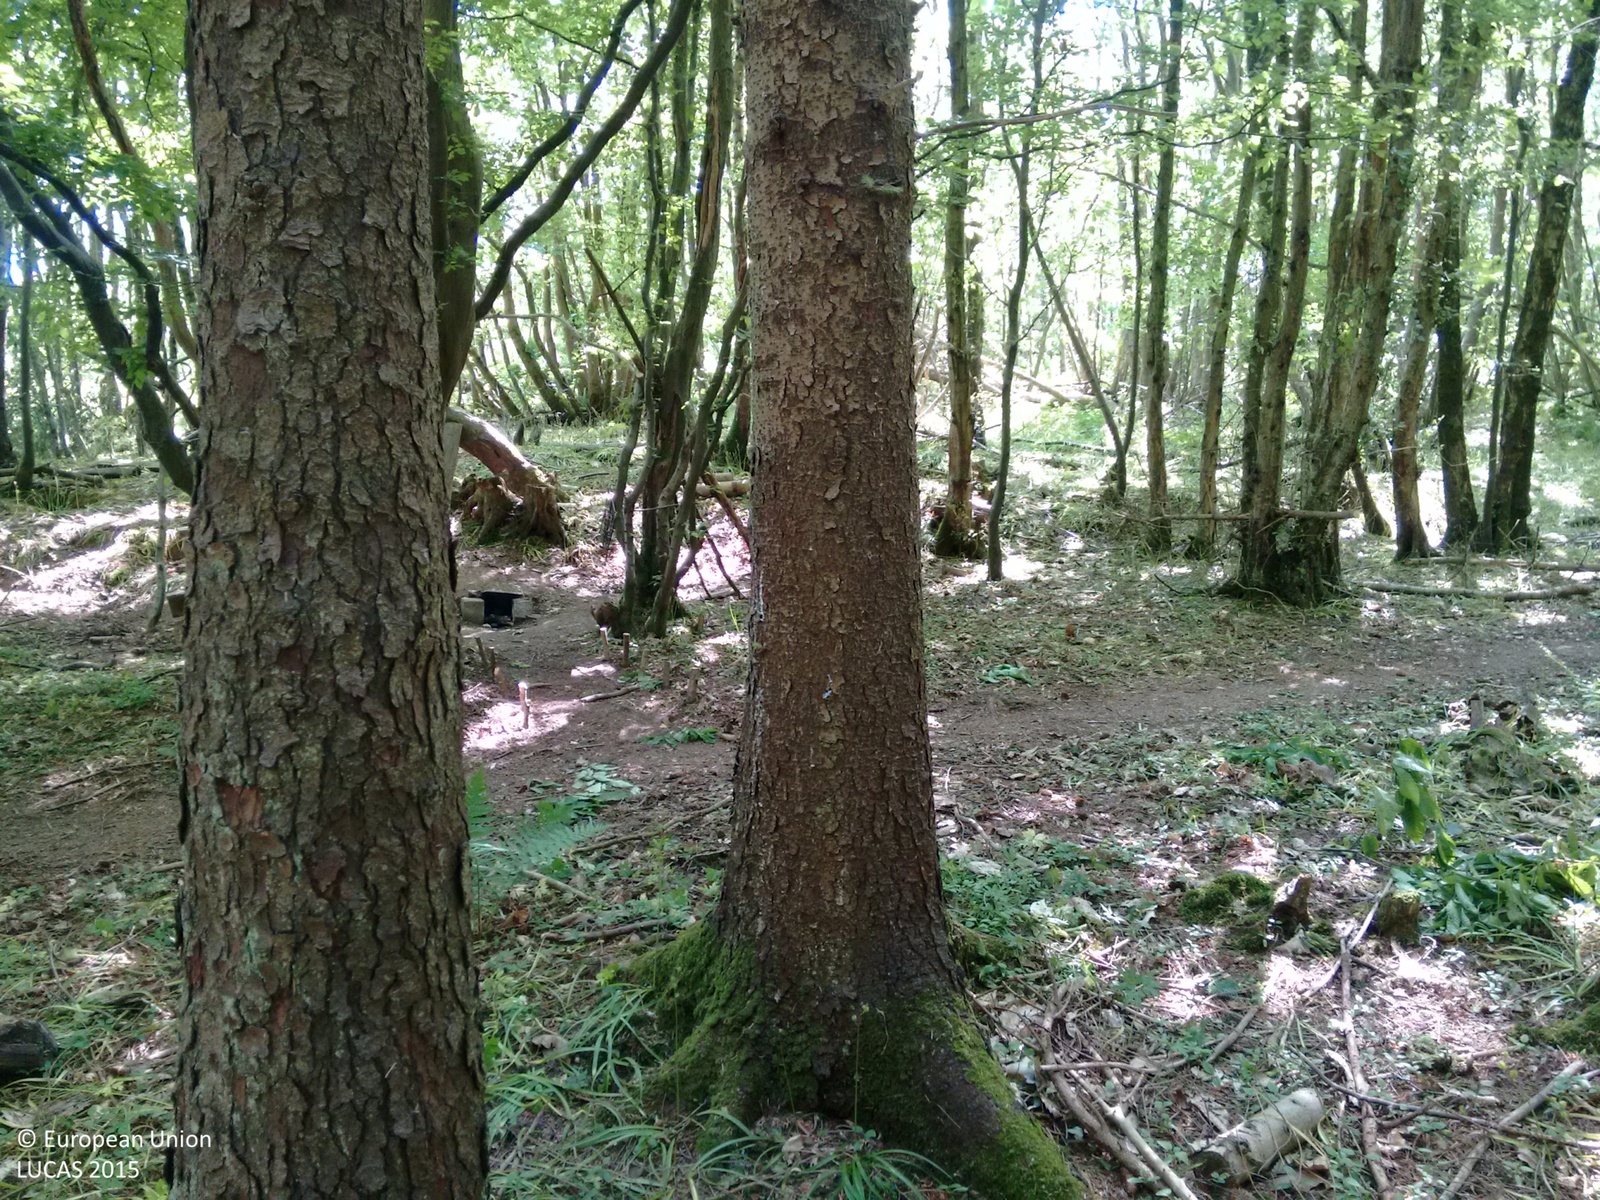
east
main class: Woodland
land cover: Other mixed woodland
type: exotic forest
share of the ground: > 75 %
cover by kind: coniferous forest trees 50 %, broadleaved forest trees 50 %
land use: Forestry
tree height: > 5 m
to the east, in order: Other mixed woodland; Shrubland with sparse tree cover; Tracks; Shrubland with sparse tree cover; Fences; Other bare soil
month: June
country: GB
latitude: 50.9818
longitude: 0.4998
